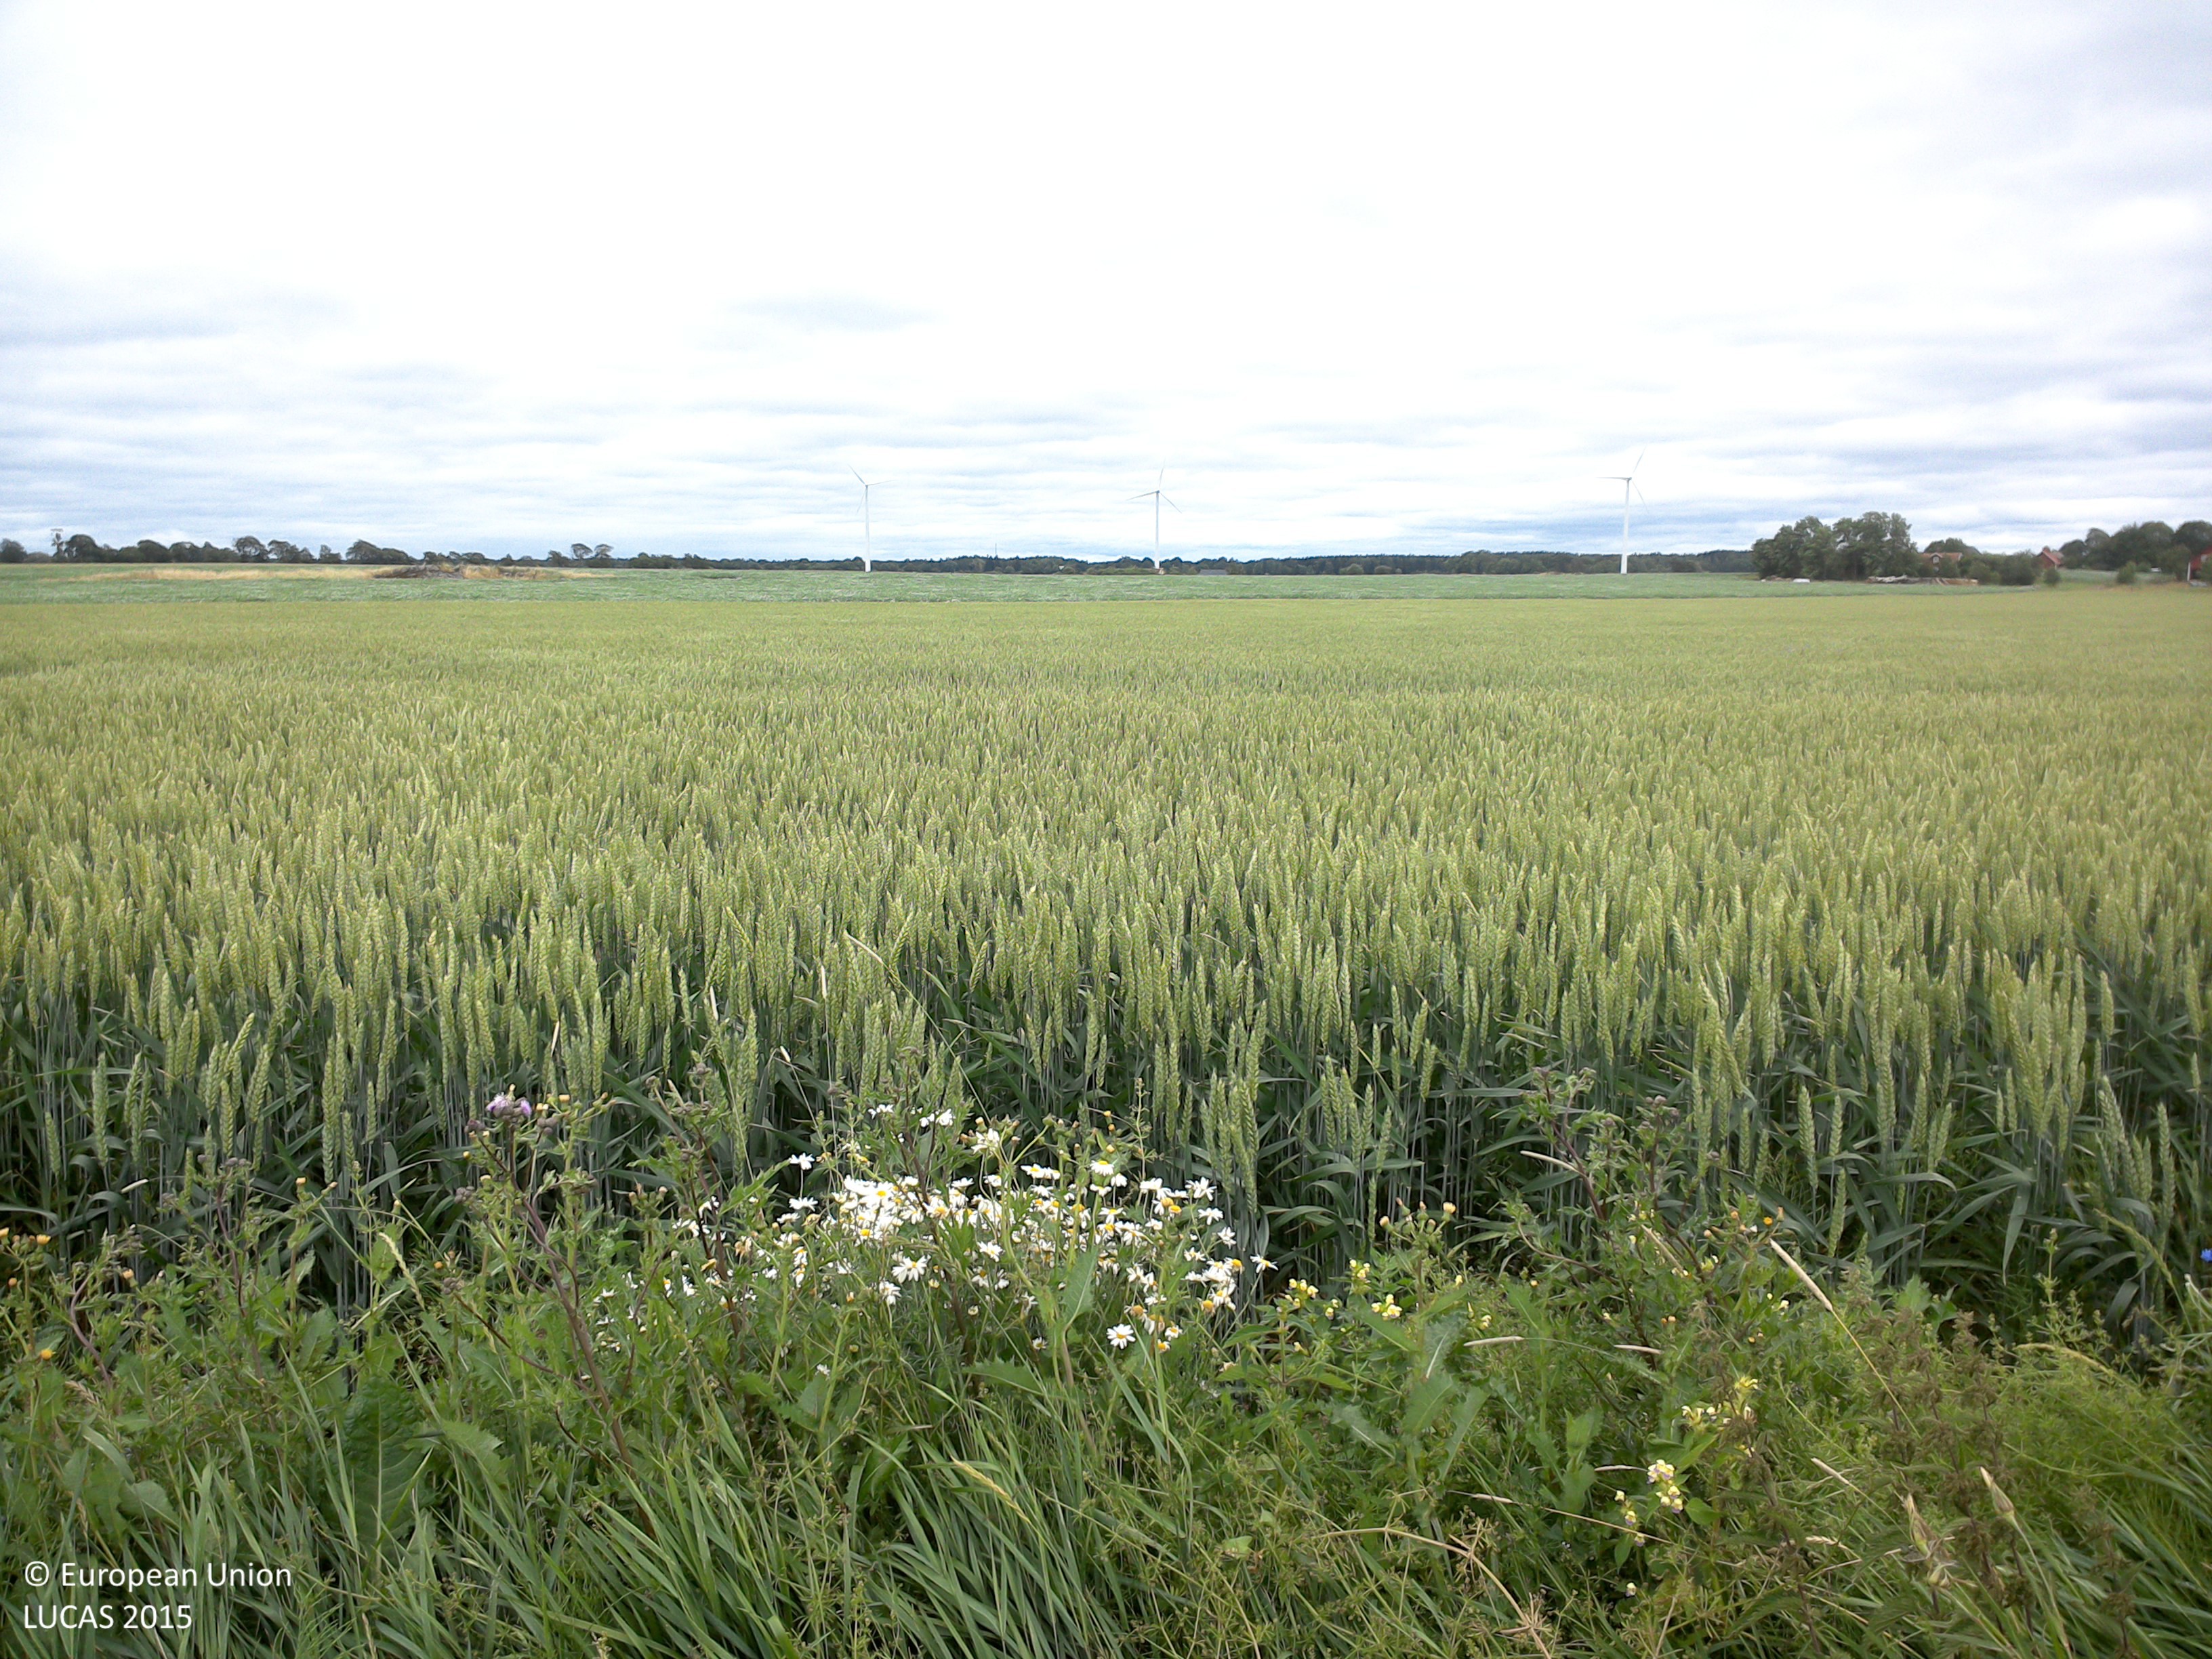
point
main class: Cropland
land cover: Dry pulses
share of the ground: > 75 %
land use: Agriculture (excluding fallow land and kitchen gardens)
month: July
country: SE
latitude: 58.2977
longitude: 14.7541
